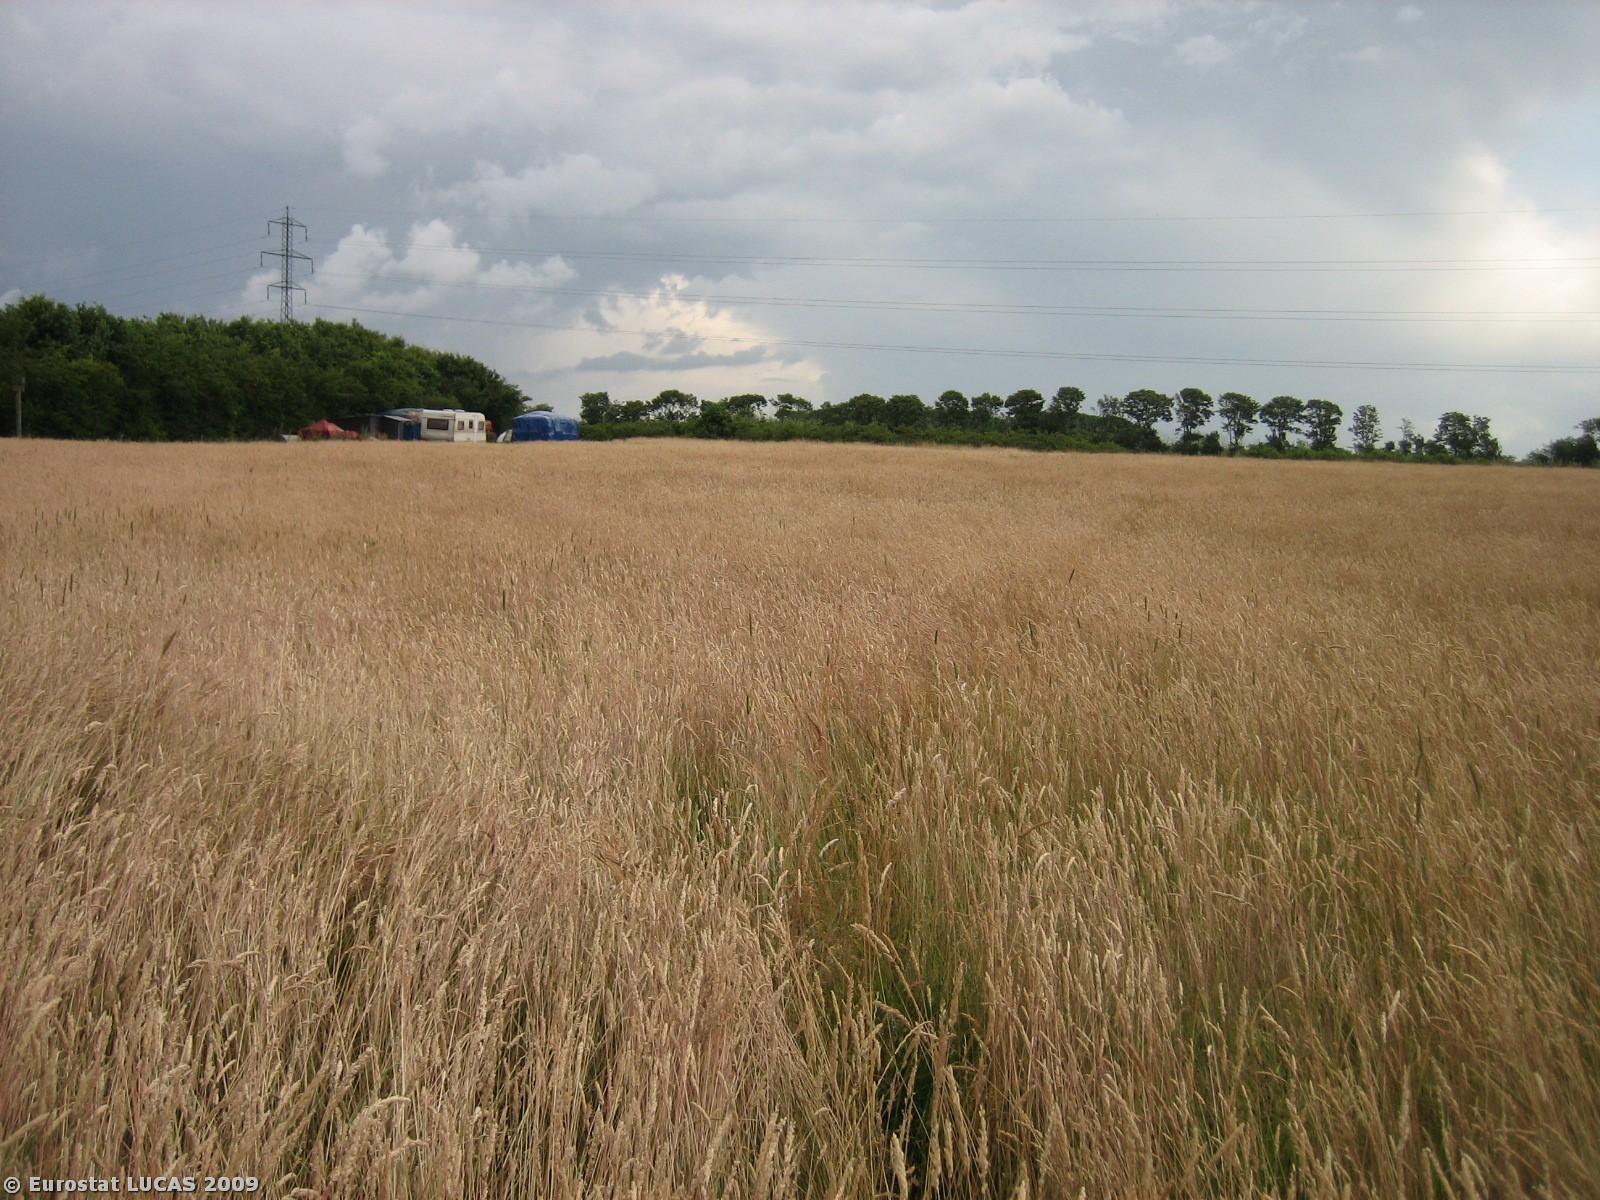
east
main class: Grassland
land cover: Grassland without tree/shrub cover
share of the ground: > 75 %
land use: Agriculture (excluding fallow land and kitchen gardens)
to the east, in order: Grassland without tree/shrub cover; Fences; Grassland without tree/shrub cover
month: July
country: DK
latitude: 55.5680
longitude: 8.5265
